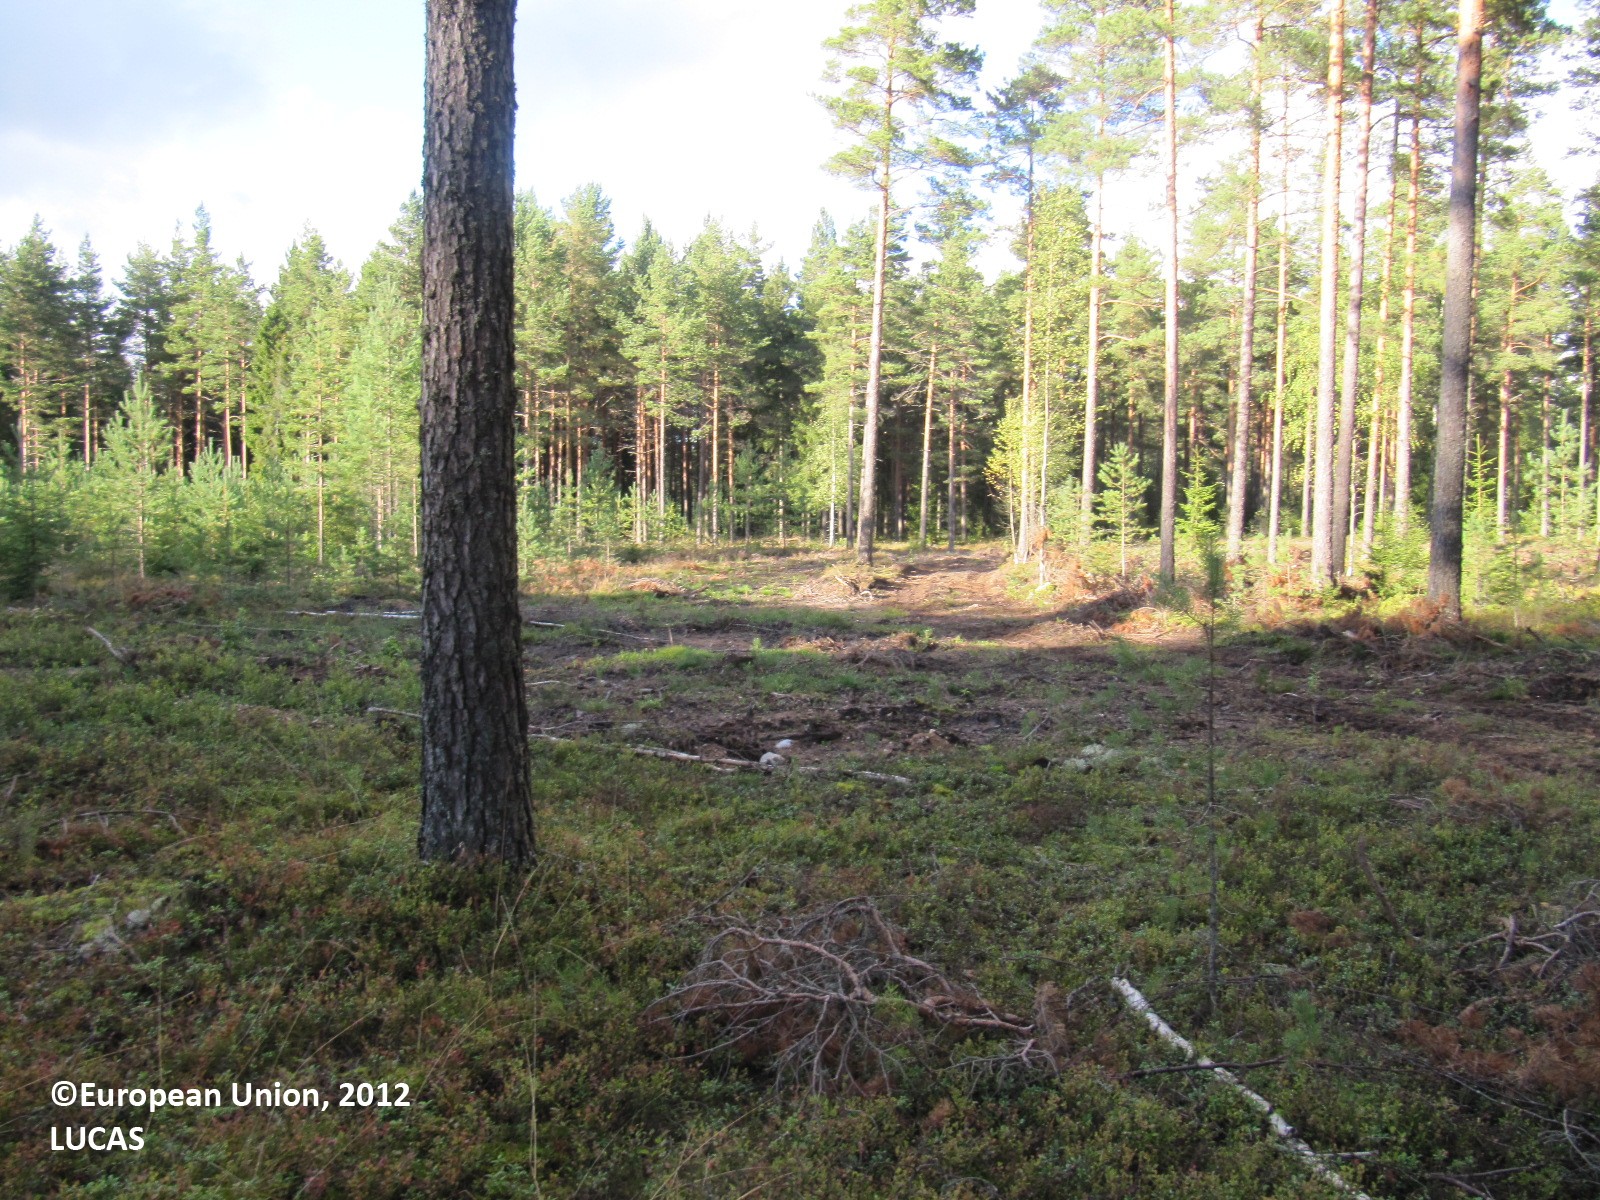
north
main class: Woodland
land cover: Pine dominated mixed woodland
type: boreal forest
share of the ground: 25 - 50 %
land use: Forestry
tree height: > 5 m
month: September
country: FI
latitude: 60.0899
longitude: 23.7399
